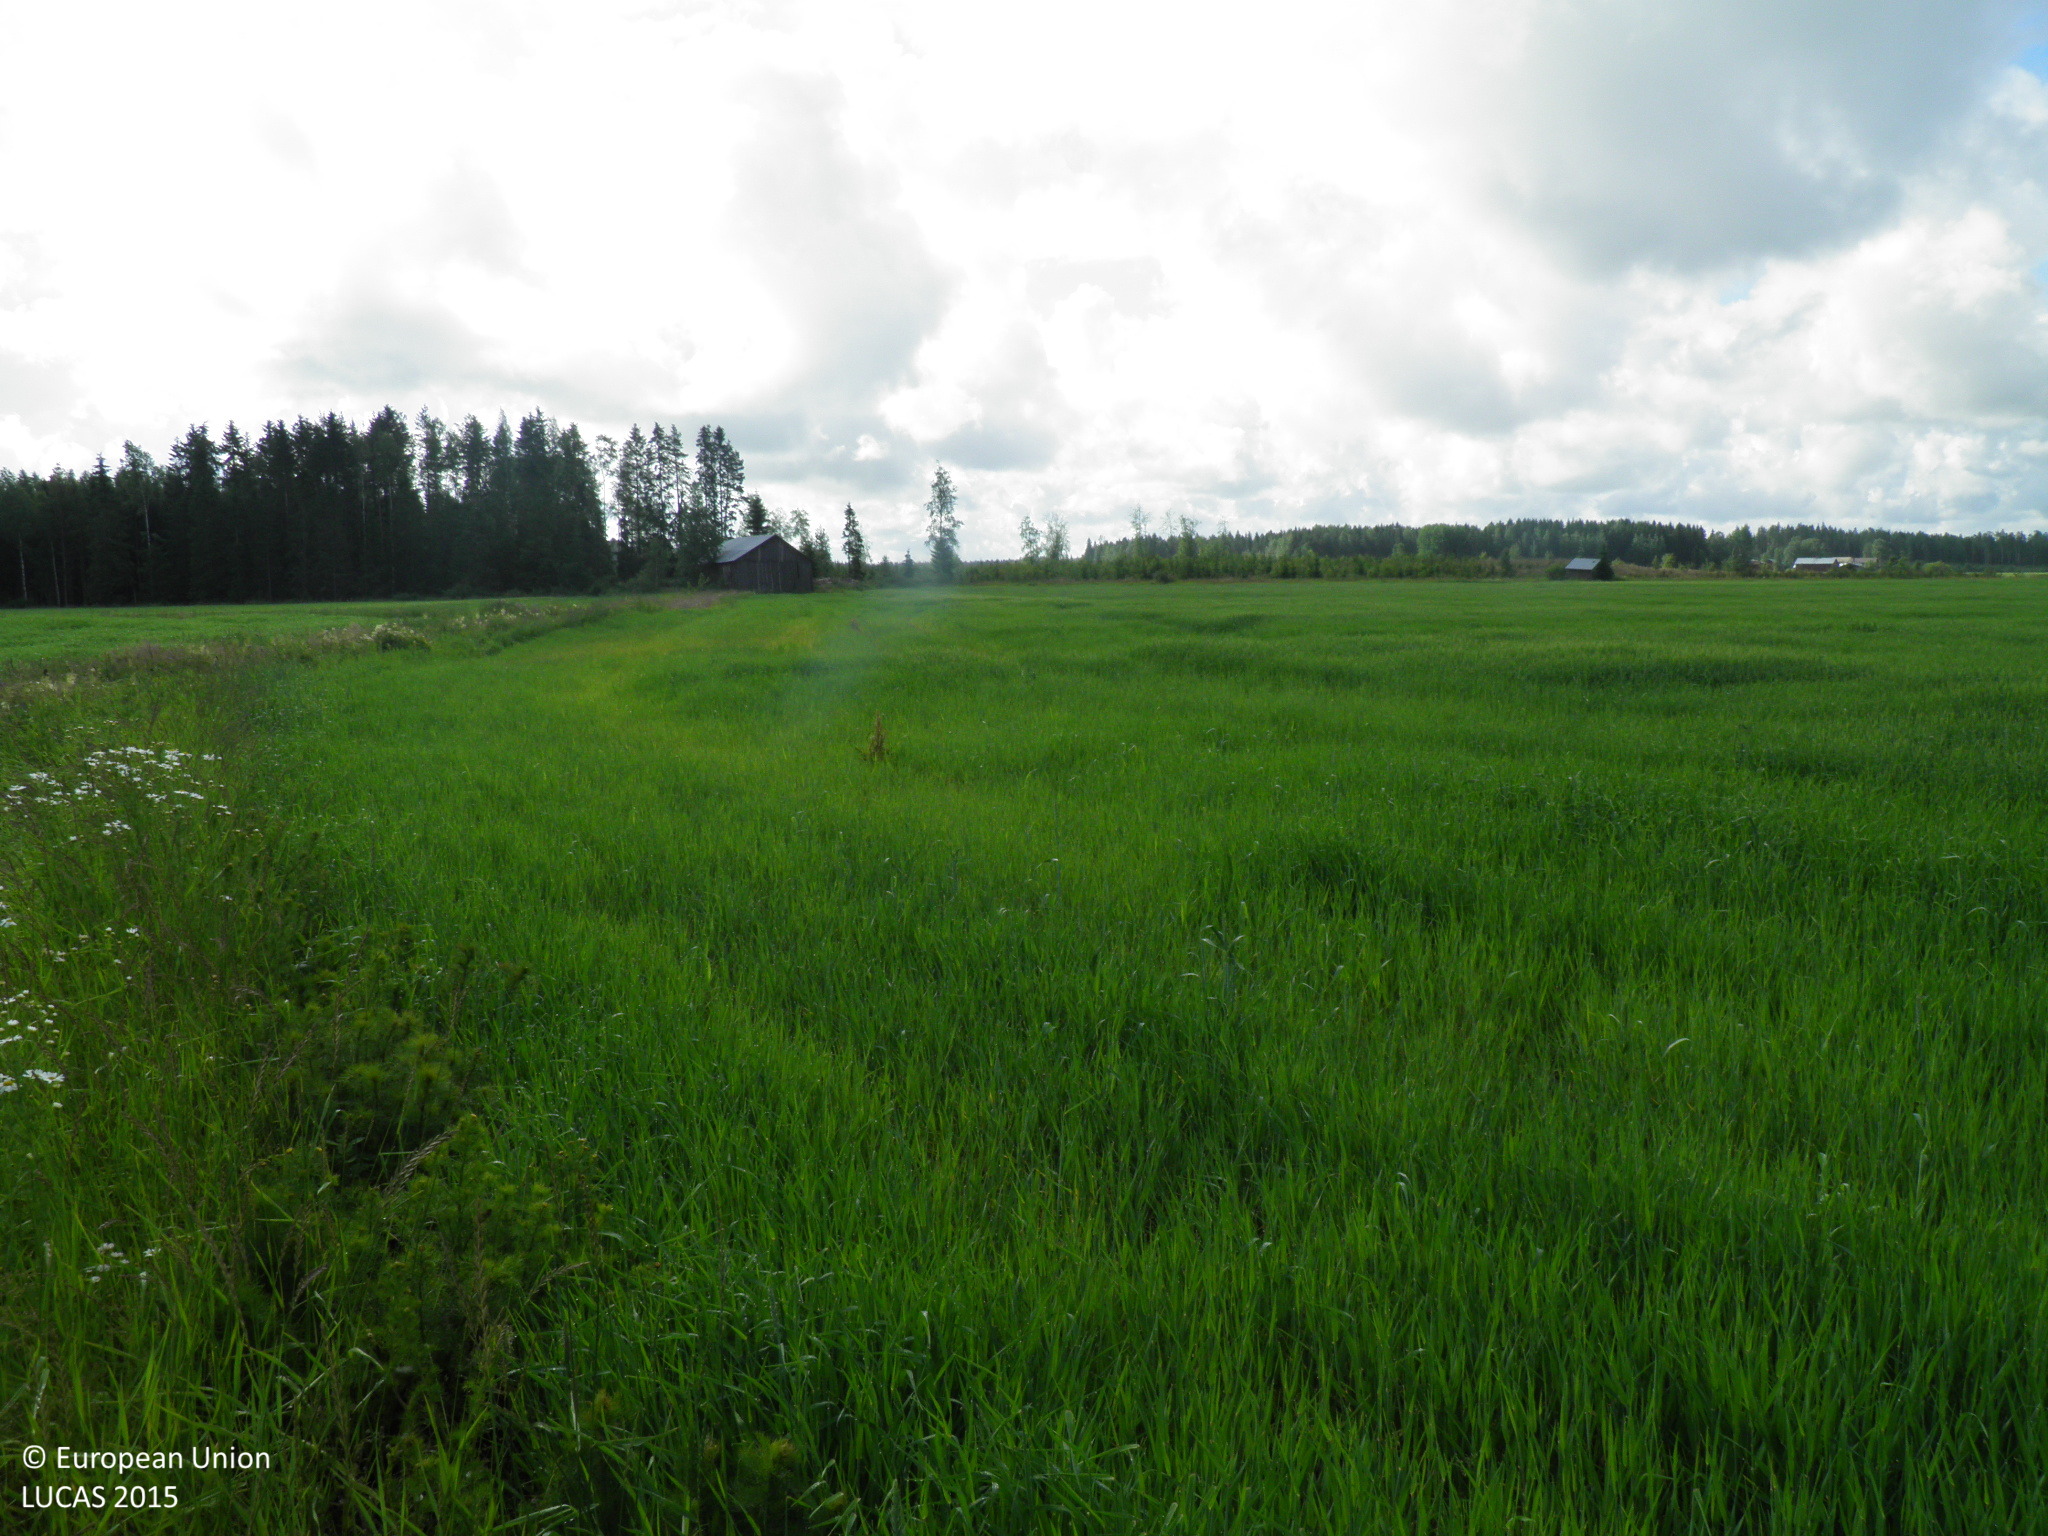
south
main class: Cropland
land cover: Barley
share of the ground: > 75 %
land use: Agriculture (excluding fallow land and kitchen gardens)
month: July
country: FI
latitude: 60.7792
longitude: 22.8363
